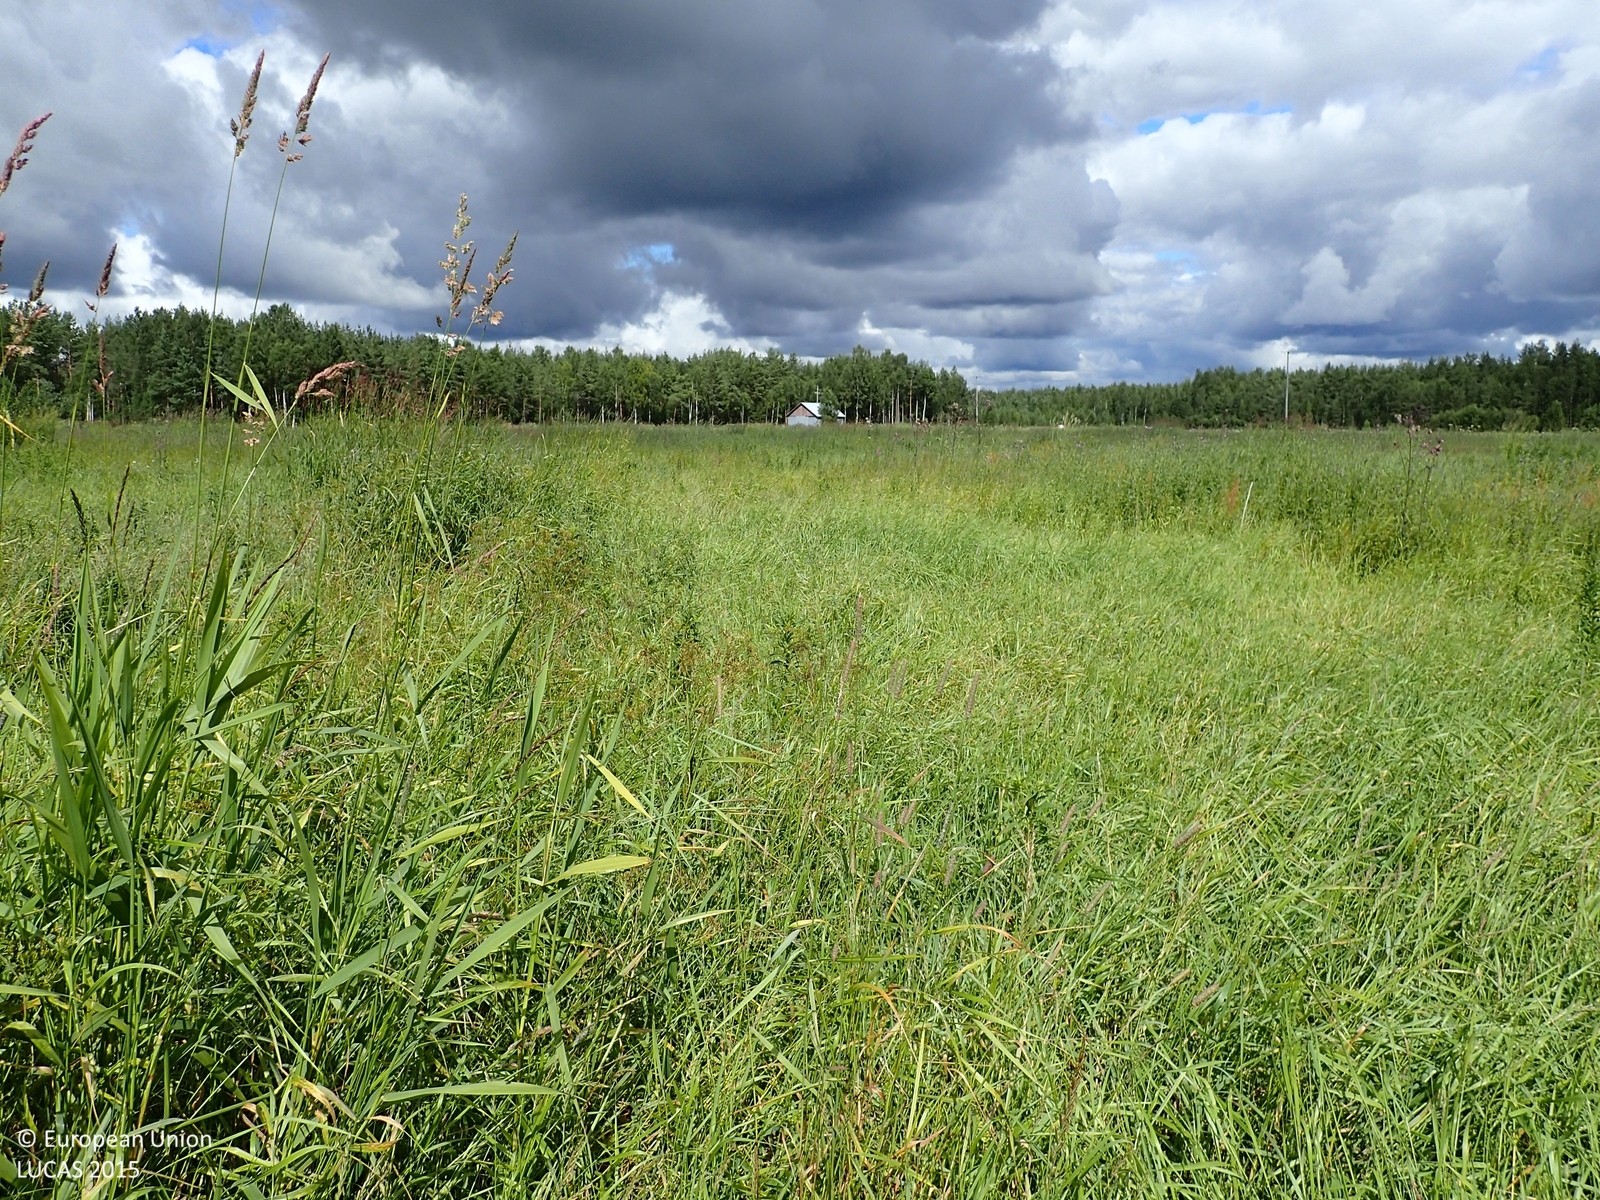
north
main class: Grassland
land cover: Spontaneously vegetated surfaces
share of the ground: > 75 %
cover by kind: herbaceous plants 100 %
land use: Fallow land
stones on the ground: < 10 %
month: August
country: FI
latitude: 62.6484
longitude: 21.6915
